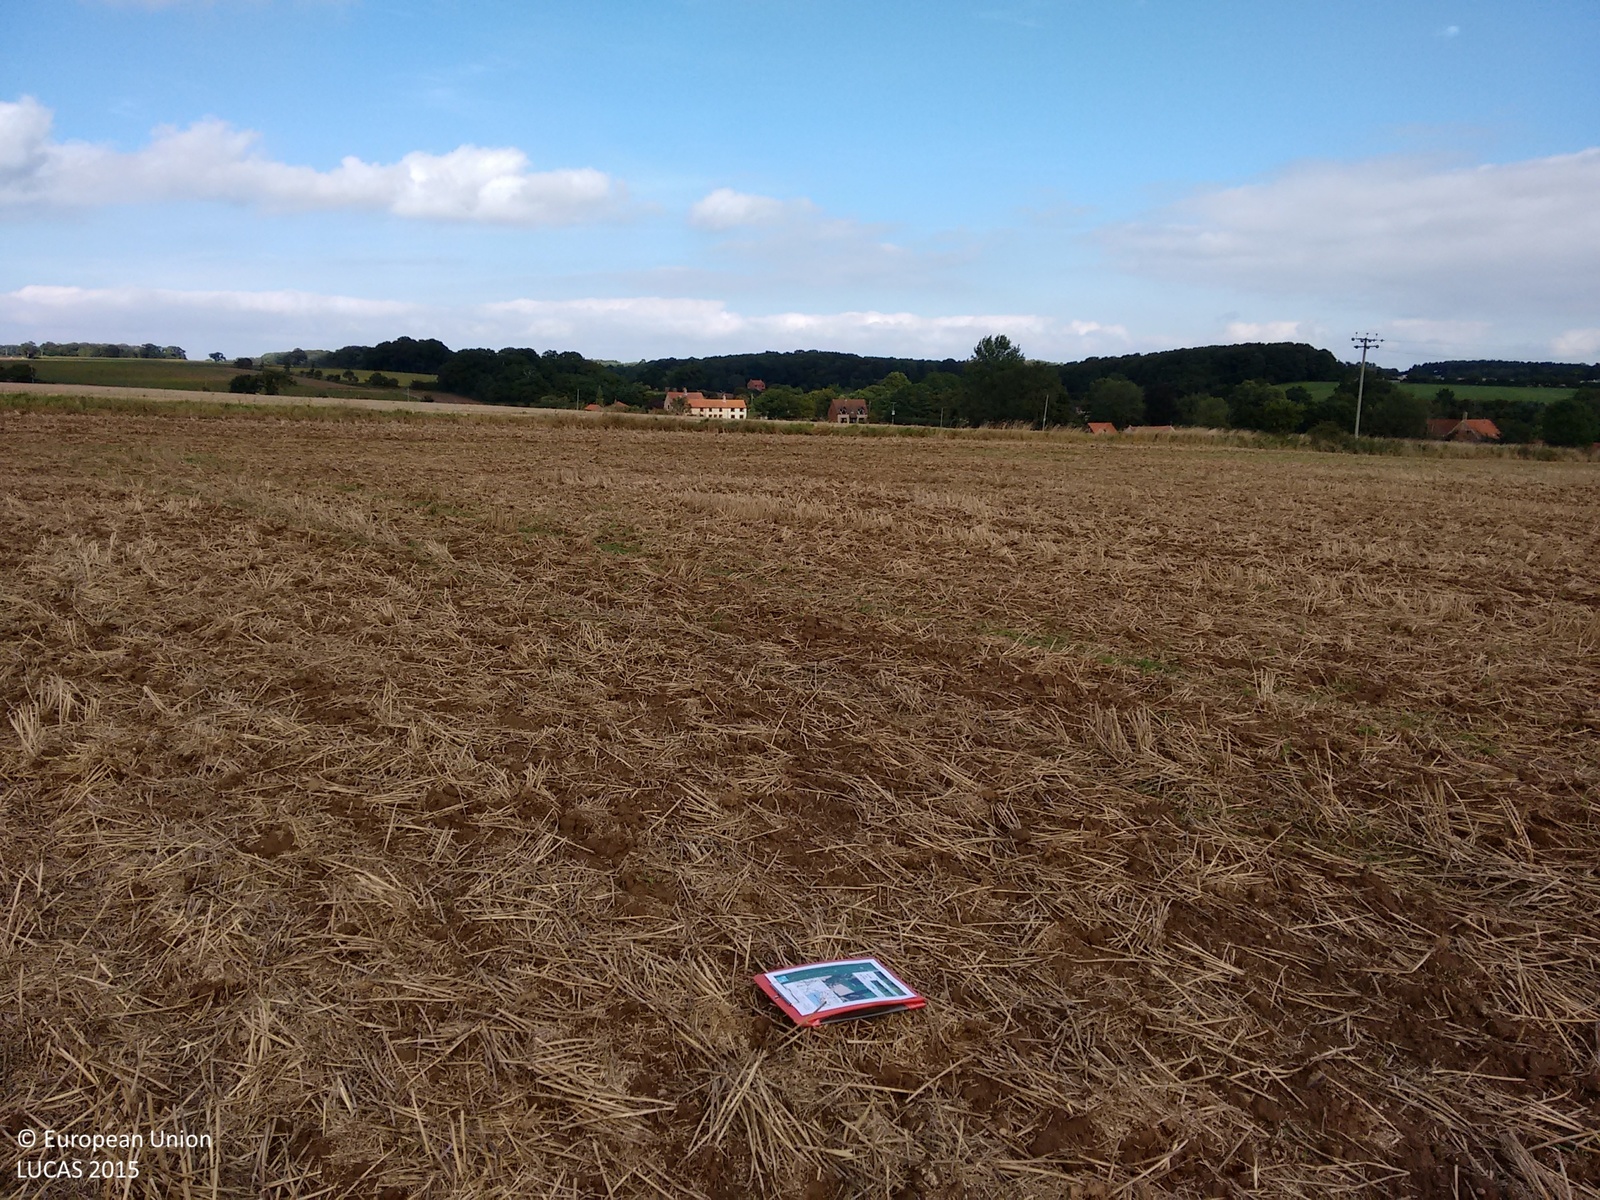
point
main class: Cropland
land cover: Common wheat
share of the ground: > 75 %
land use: Agriculture (excluding fallow land and kitchen gardens)
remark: Harvested field
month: September
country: GB
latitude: 52.8884
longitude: 1.2851
